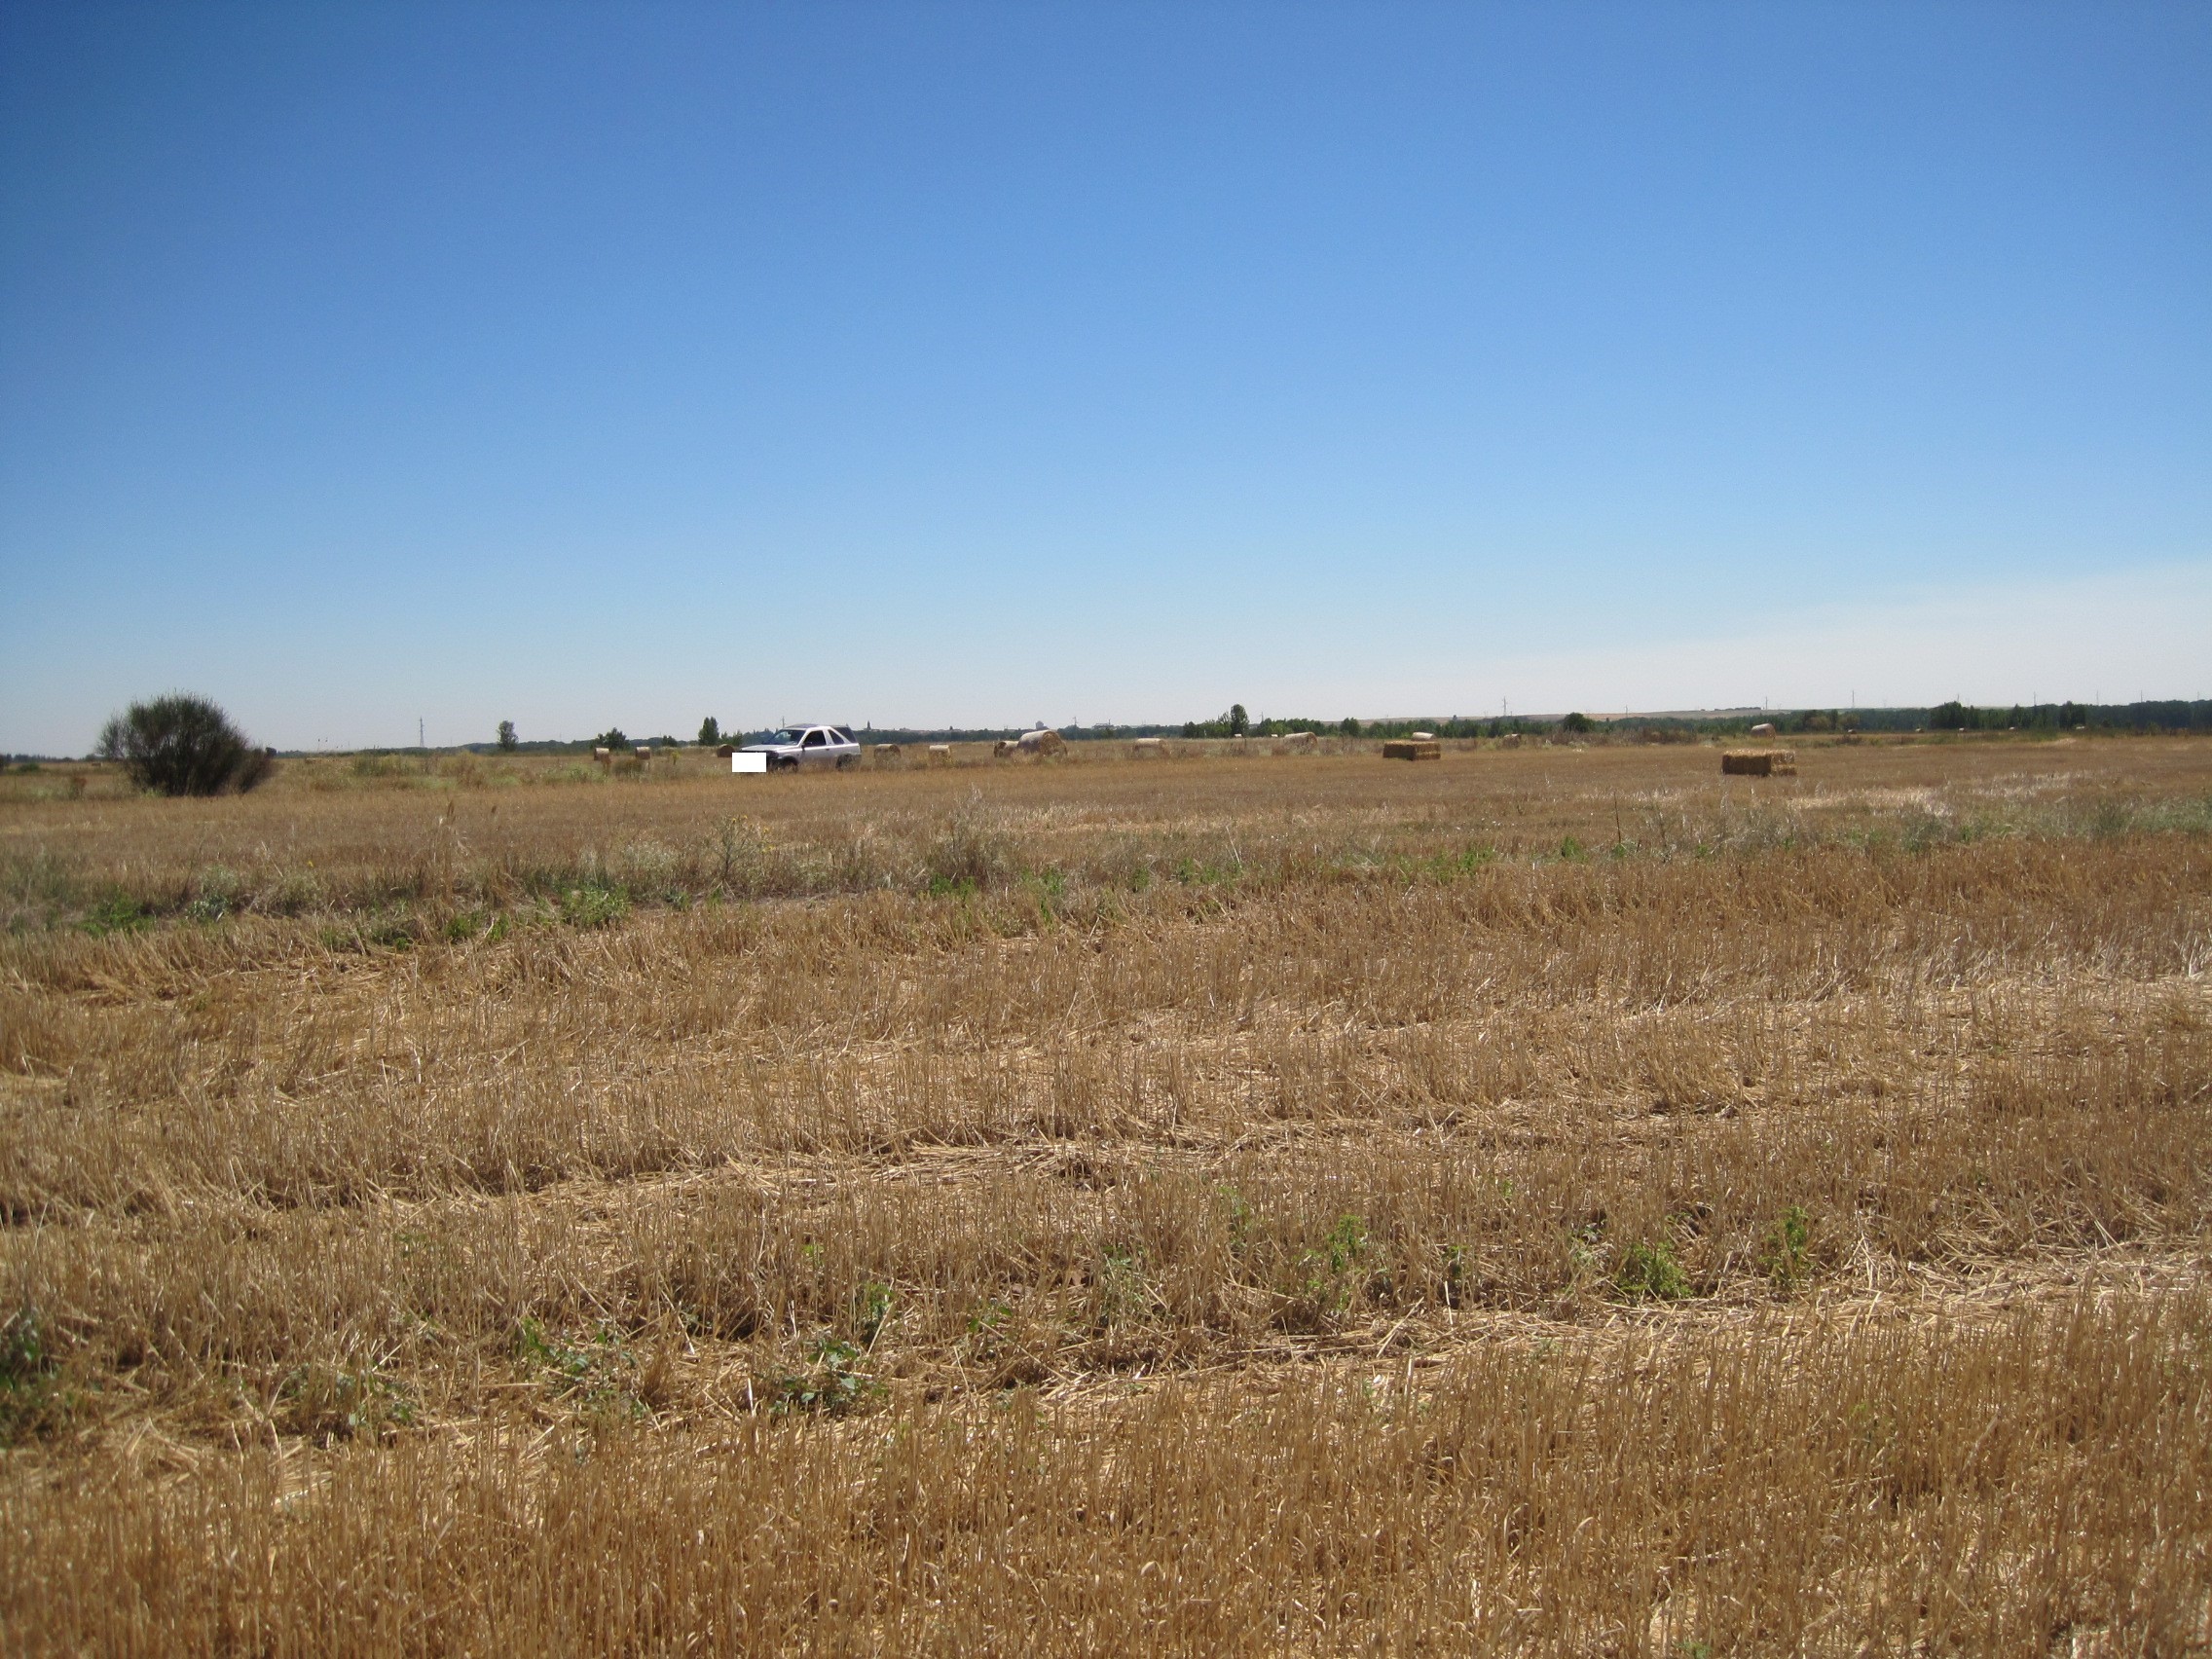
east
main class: Cropland
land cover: Common wheat
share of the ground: < 10 %
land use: Agriculture (excluding fallow land and kitchen gardens)
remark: Harvested field
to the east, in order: Common wheat; Grass margins; Tracks; Grass margins; Rye; Grass margins; Tracks; Grass margins; Triticale
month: July
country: ES
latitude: 42.1588
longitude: -5.3242
